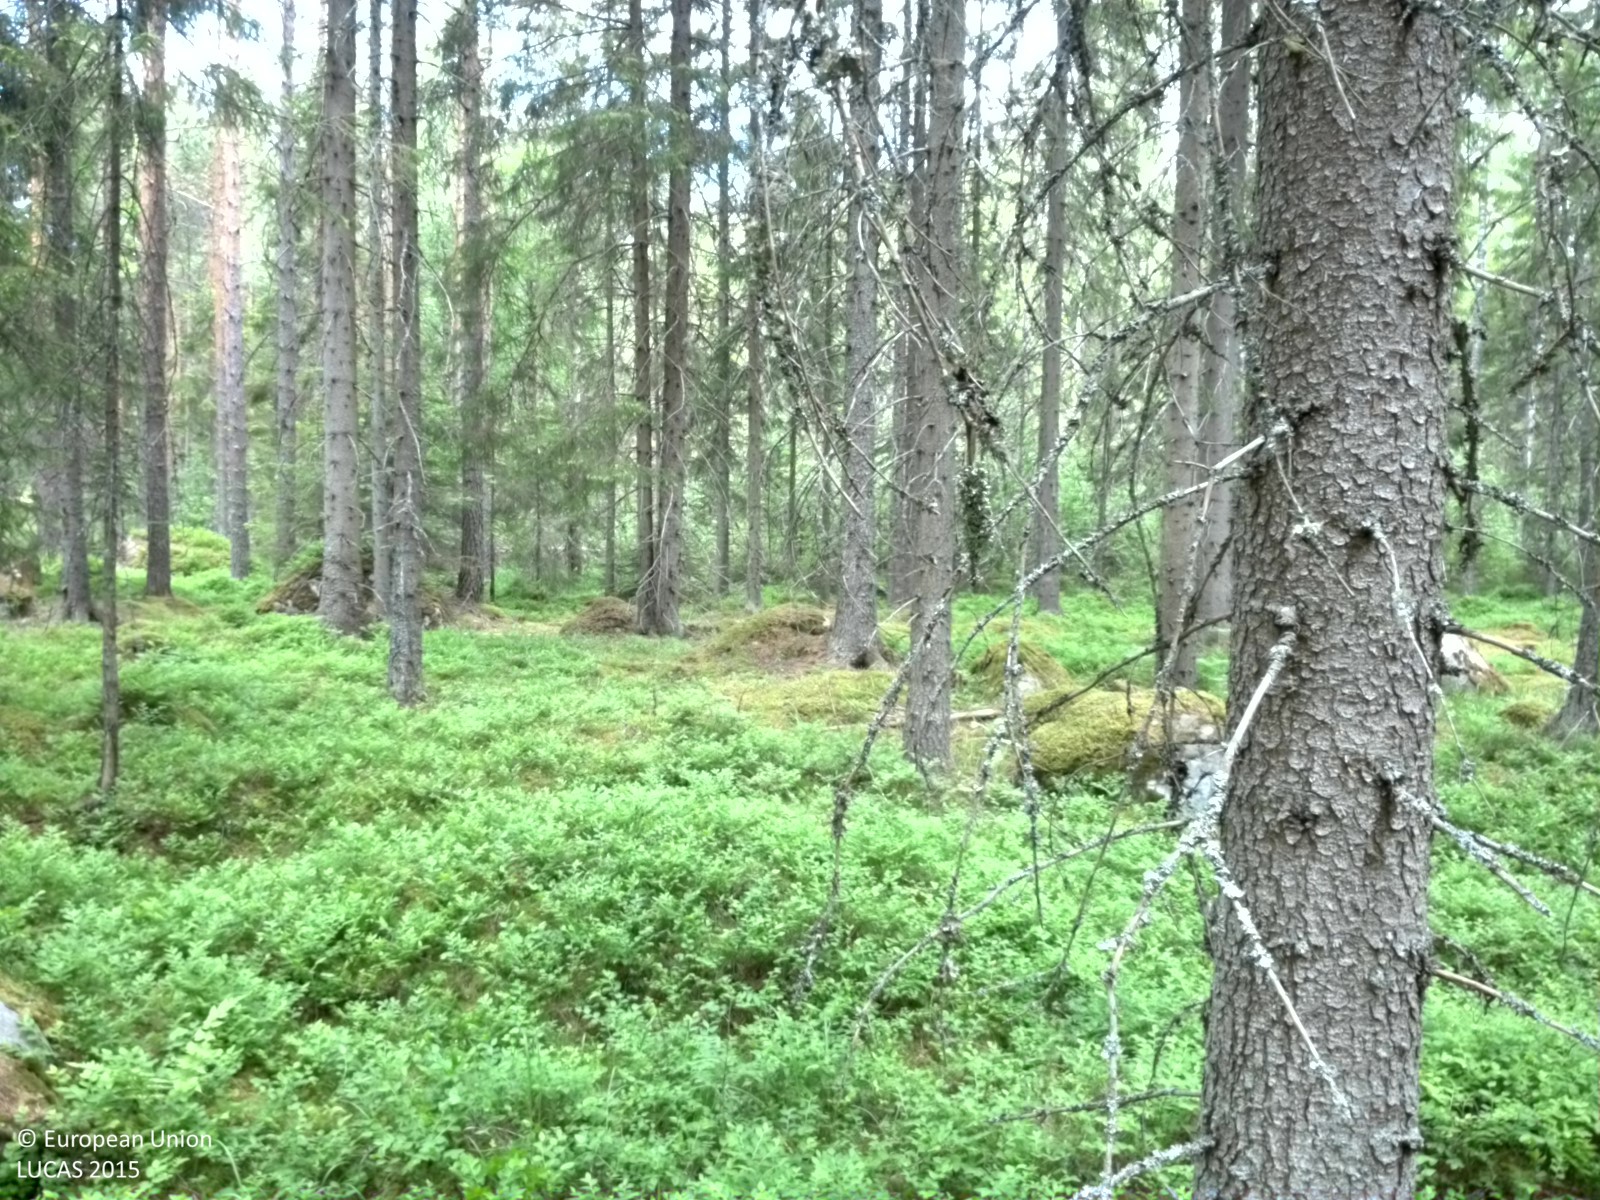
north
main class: Woodland
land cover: Spruce dominated coniferous woodland
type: boreal forest
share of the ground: > 75 %
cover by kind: coniferous forest trees 70 %, shrubs 20 %, broadleaved forest trees 5 %, herbaceous plants 5 %
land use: Forestry
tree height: > 5 m
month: June
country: SE
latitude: 60.3449
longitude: 17.1112
